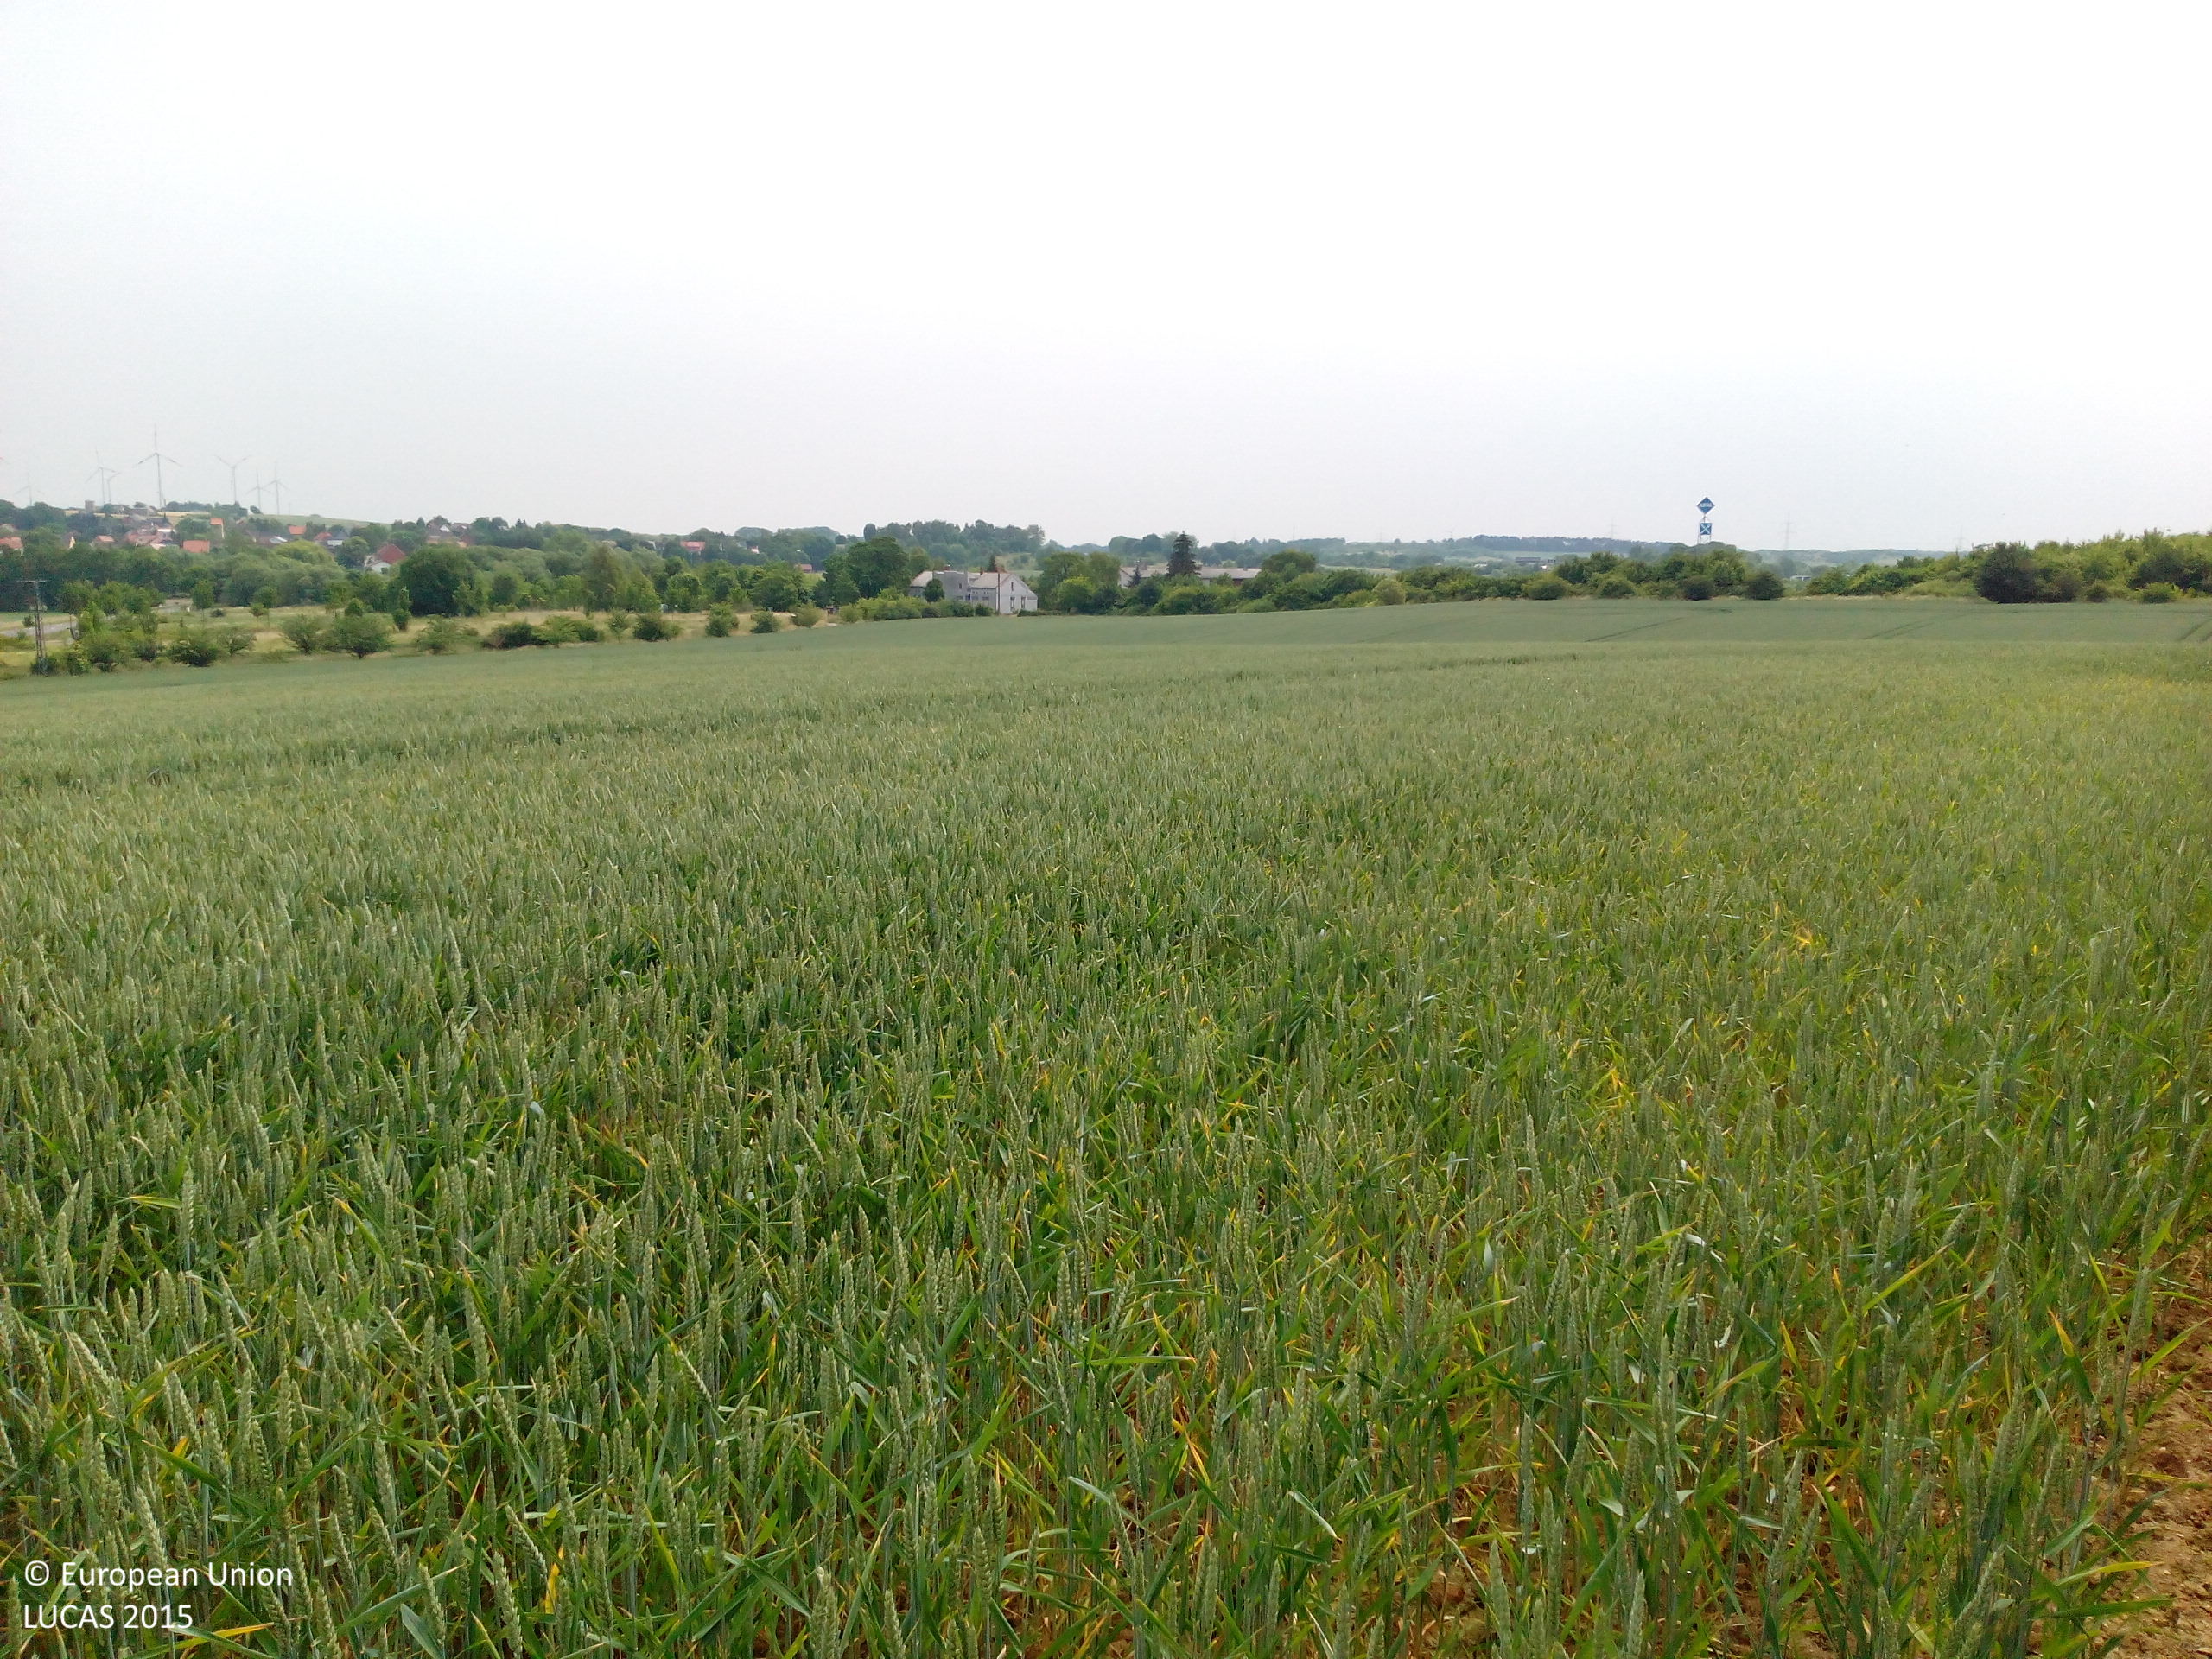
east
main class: Woodland
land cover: Broadleaved woodland
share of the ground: > 75 %
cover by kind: broadleaved forest trees 100 %
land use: Forestry
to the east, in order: Broadleaved woodland; Grassland without tree/shrub cover; Common wheat
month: June
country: DE
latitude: 52.2103
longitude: 11.1265
